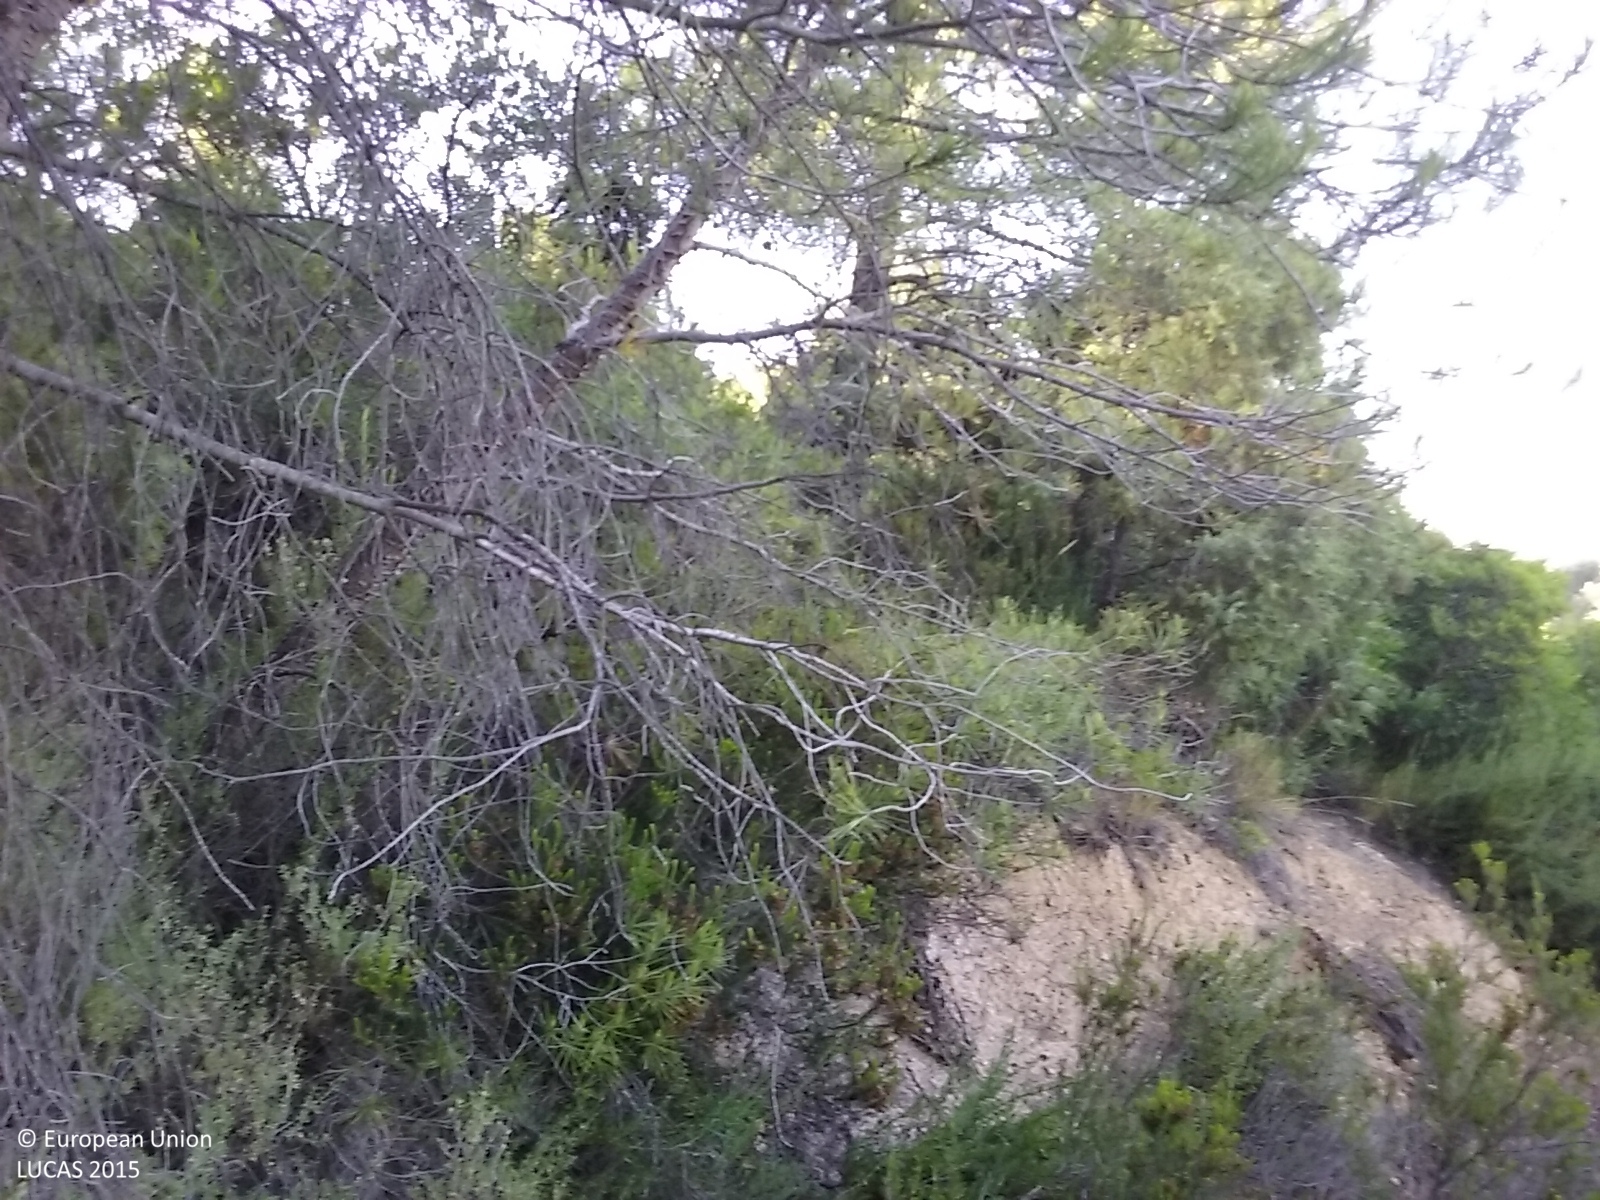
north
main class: Woodland
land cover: Pine dominated coniferous woodland
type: coniferous forest of the mediterranean region
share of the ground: 25 - 50 %
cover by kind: shrubs 75 %, coniferous forest trees 25 %
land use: Semi-natural and natural areas not in use
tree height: > 5 m
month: June
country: ES
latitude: 40.9985
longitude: 0.2307
